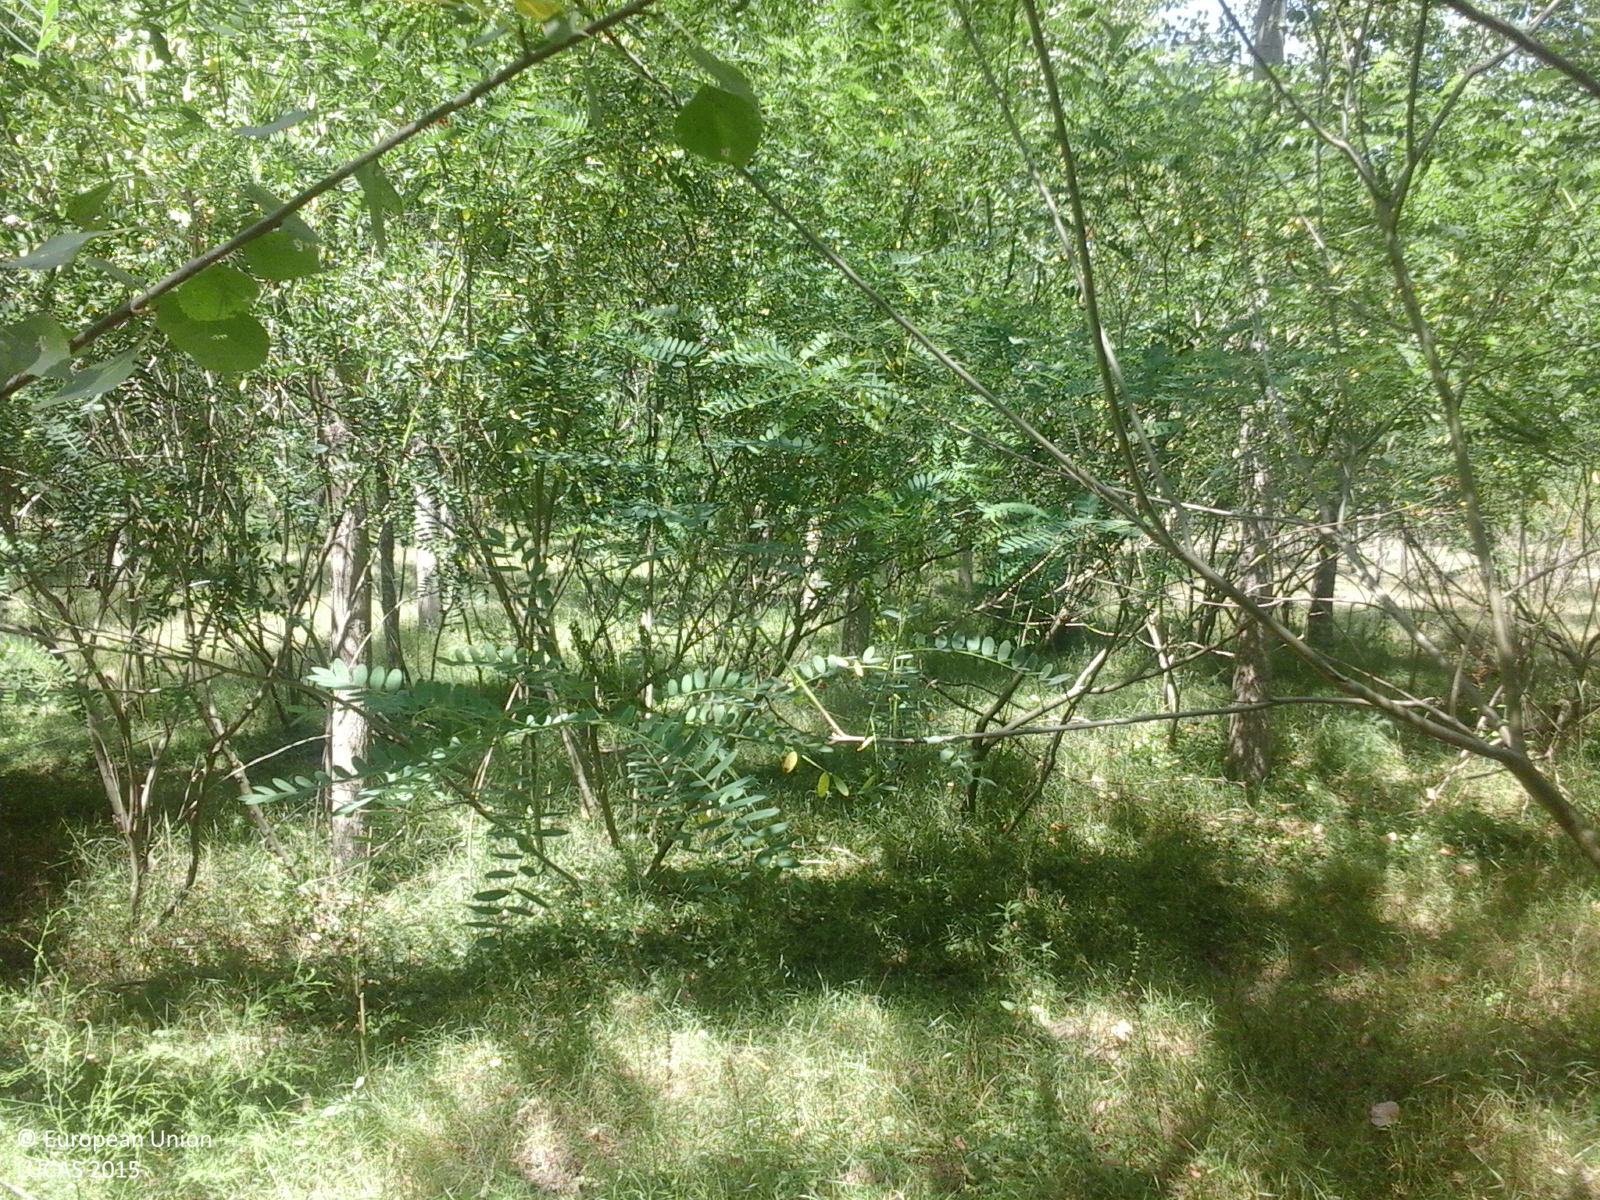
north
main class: Woodland
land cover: Broadleaved woodland
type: floodplain forest
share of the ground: > 75 %
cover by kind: broadleaved forest trees 80 %, herbaceous plants 20 %
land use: Forestry
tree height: > 5 m
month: July
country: RO
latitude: 44.1294
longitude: 27.4470
